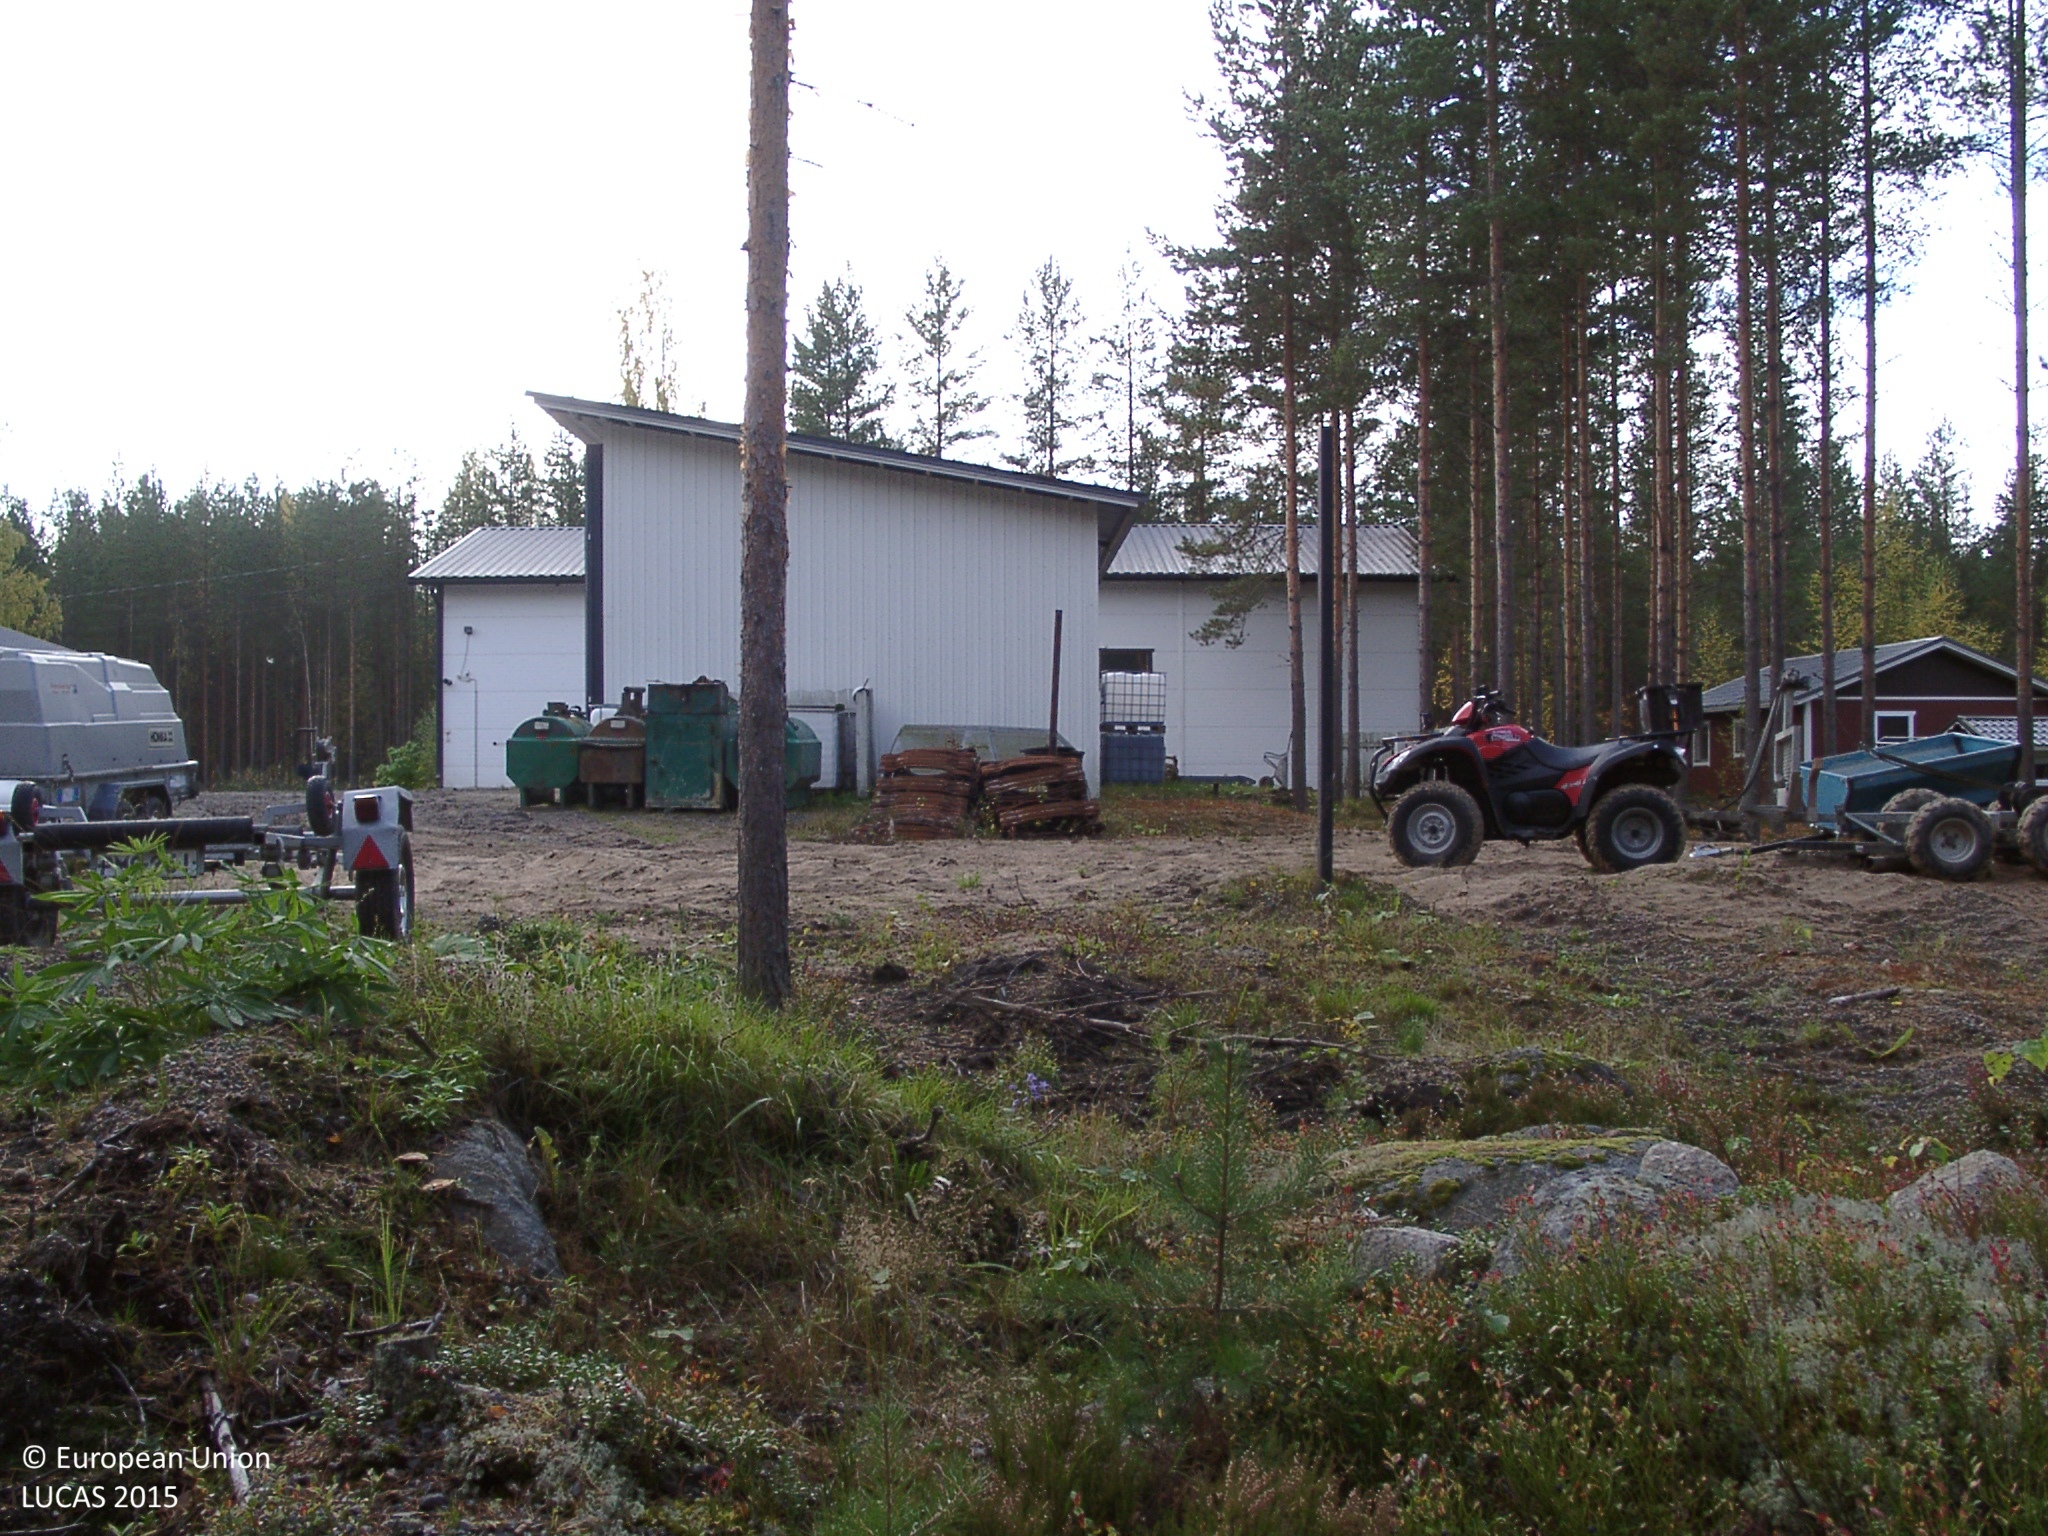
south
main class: Shrubland
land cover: Shrubland without tree cover
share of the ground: > 75 %
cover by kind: shrubs 80 %, lichens and mosses 20 %
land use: Electricity, gas and thermal power distribution
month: September
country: FI
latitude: 62.6837
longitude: 25.3618
